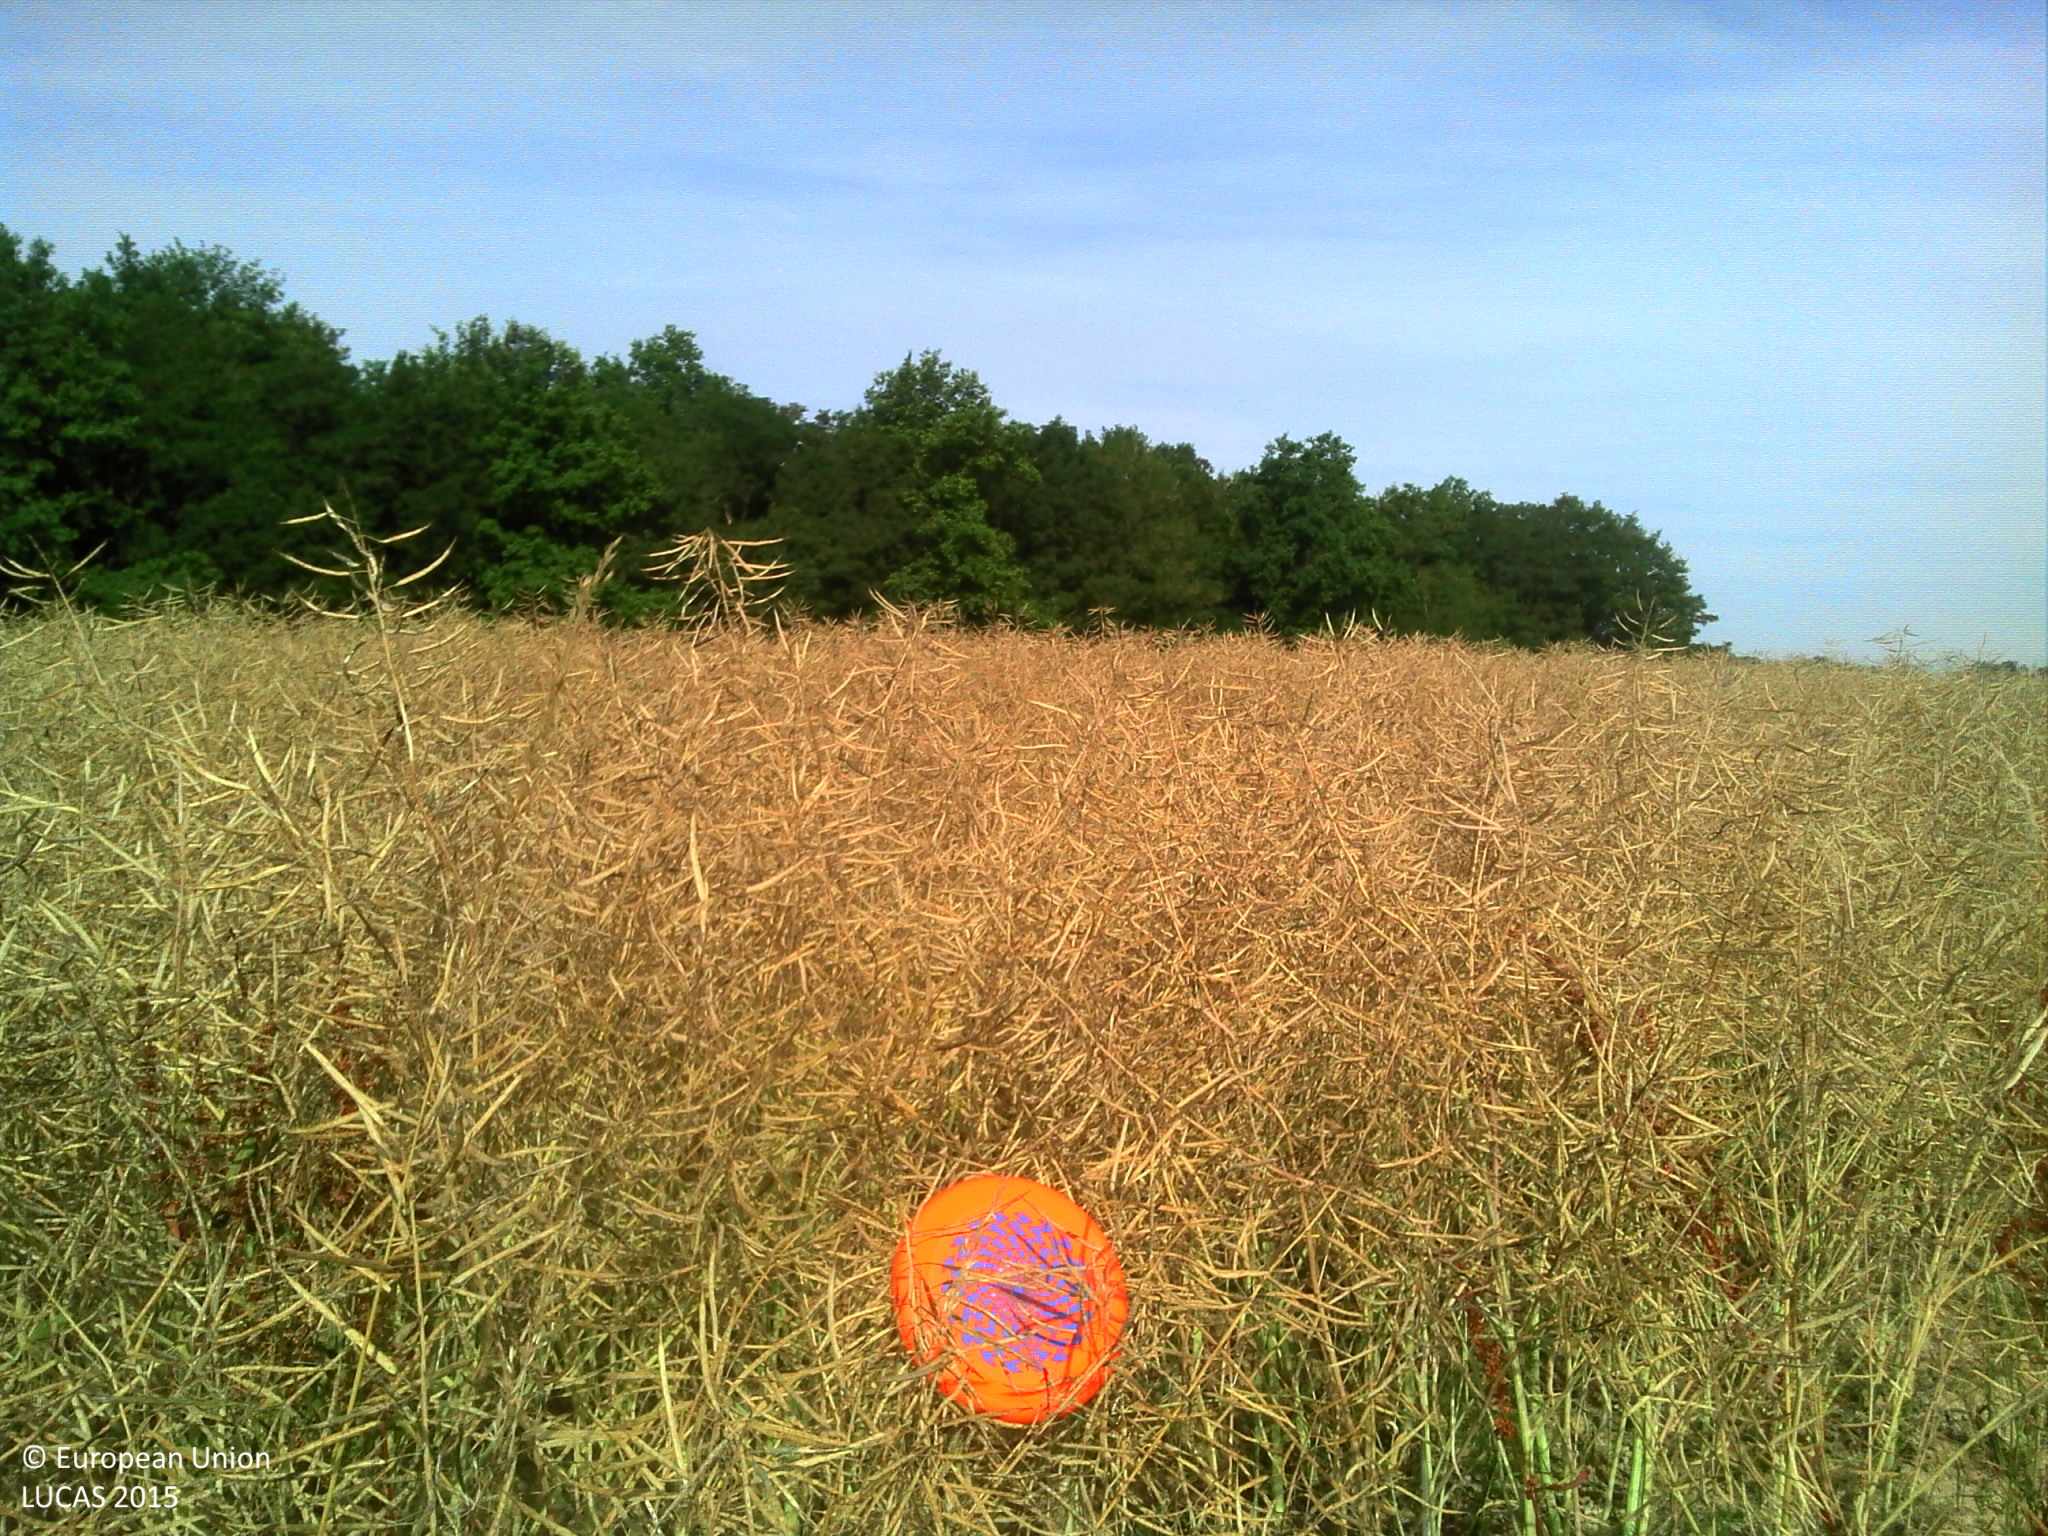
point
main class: Cropland
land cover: Rape and turnip rape
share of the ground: > 75 %
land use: Agriculture (excluding fallow land and kitchen gardens)
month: June
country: FR
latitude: 46.7136
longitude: 4.8342
